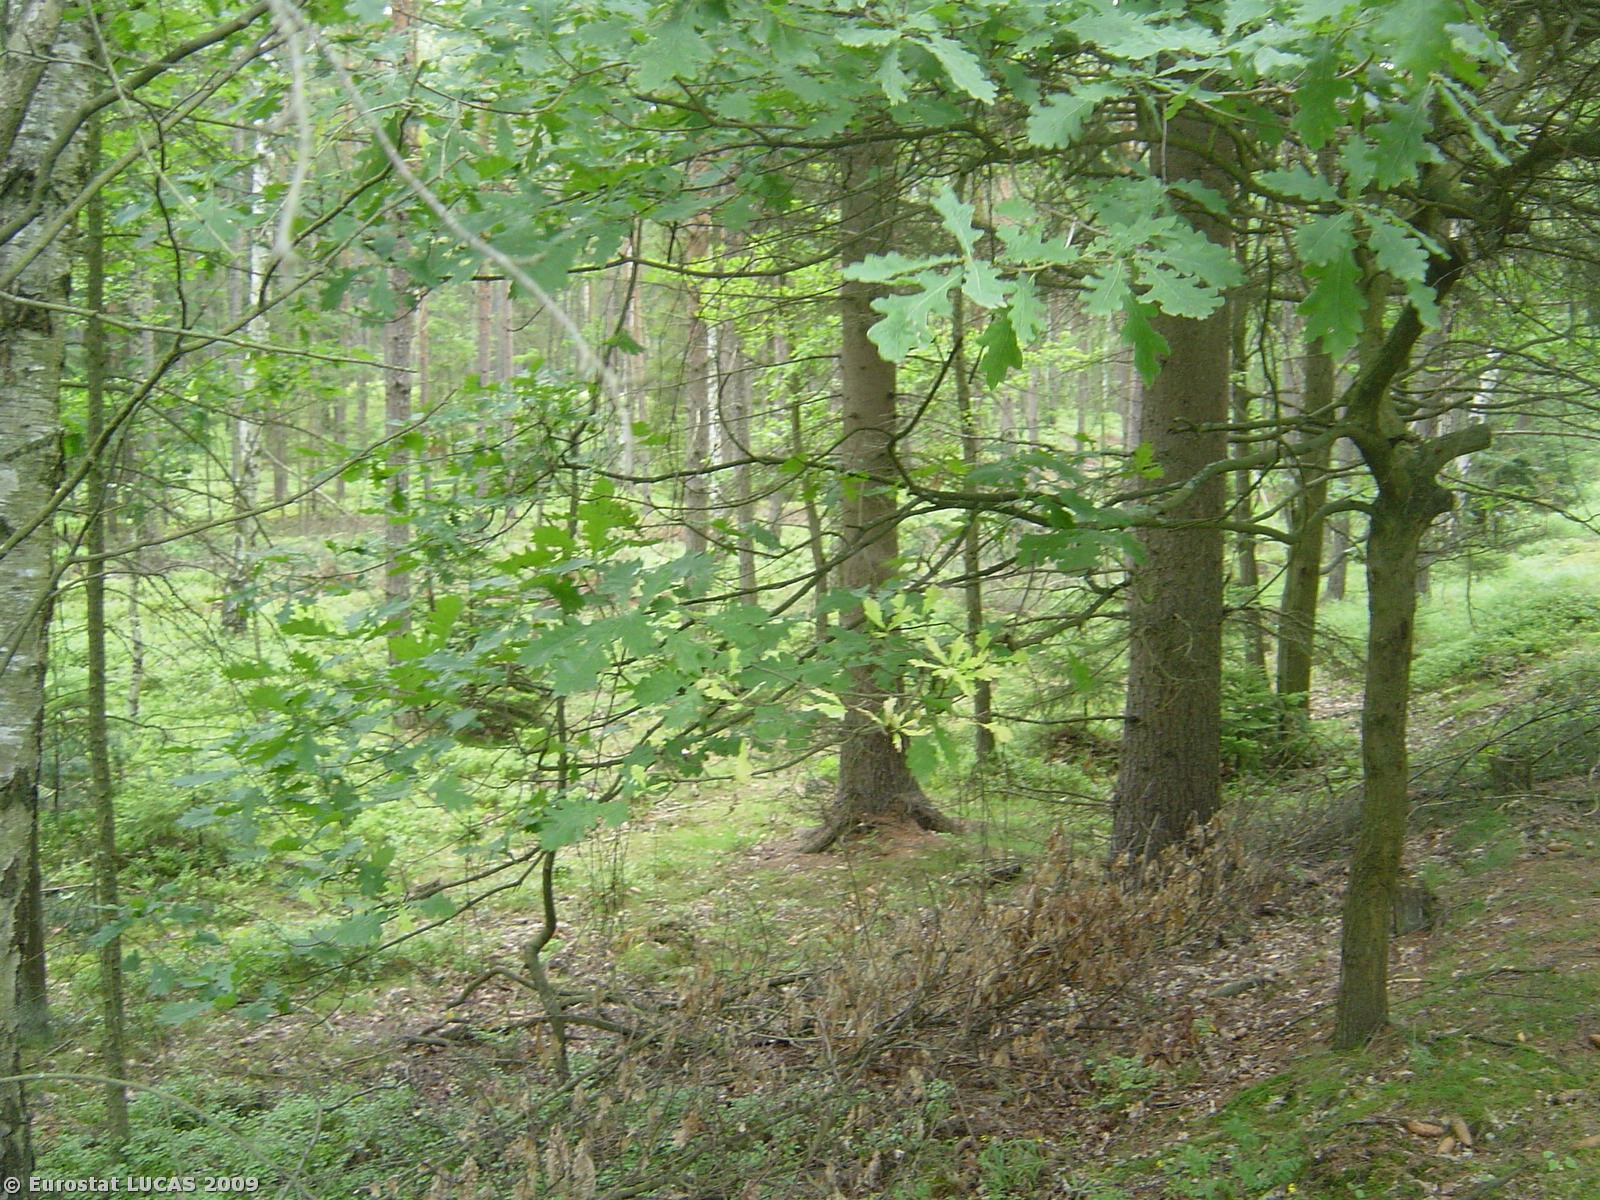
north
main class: Woodland
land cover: Mixed woodland
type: hemiboreal forest and nemoral coniferous forest and mixed broadleaved-coniferous forest
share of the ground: > 75 %
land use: Forestry
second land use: Nature reserves
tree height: > 5 m
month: July
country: CZ
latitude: 49.9049
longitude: 13.2164
